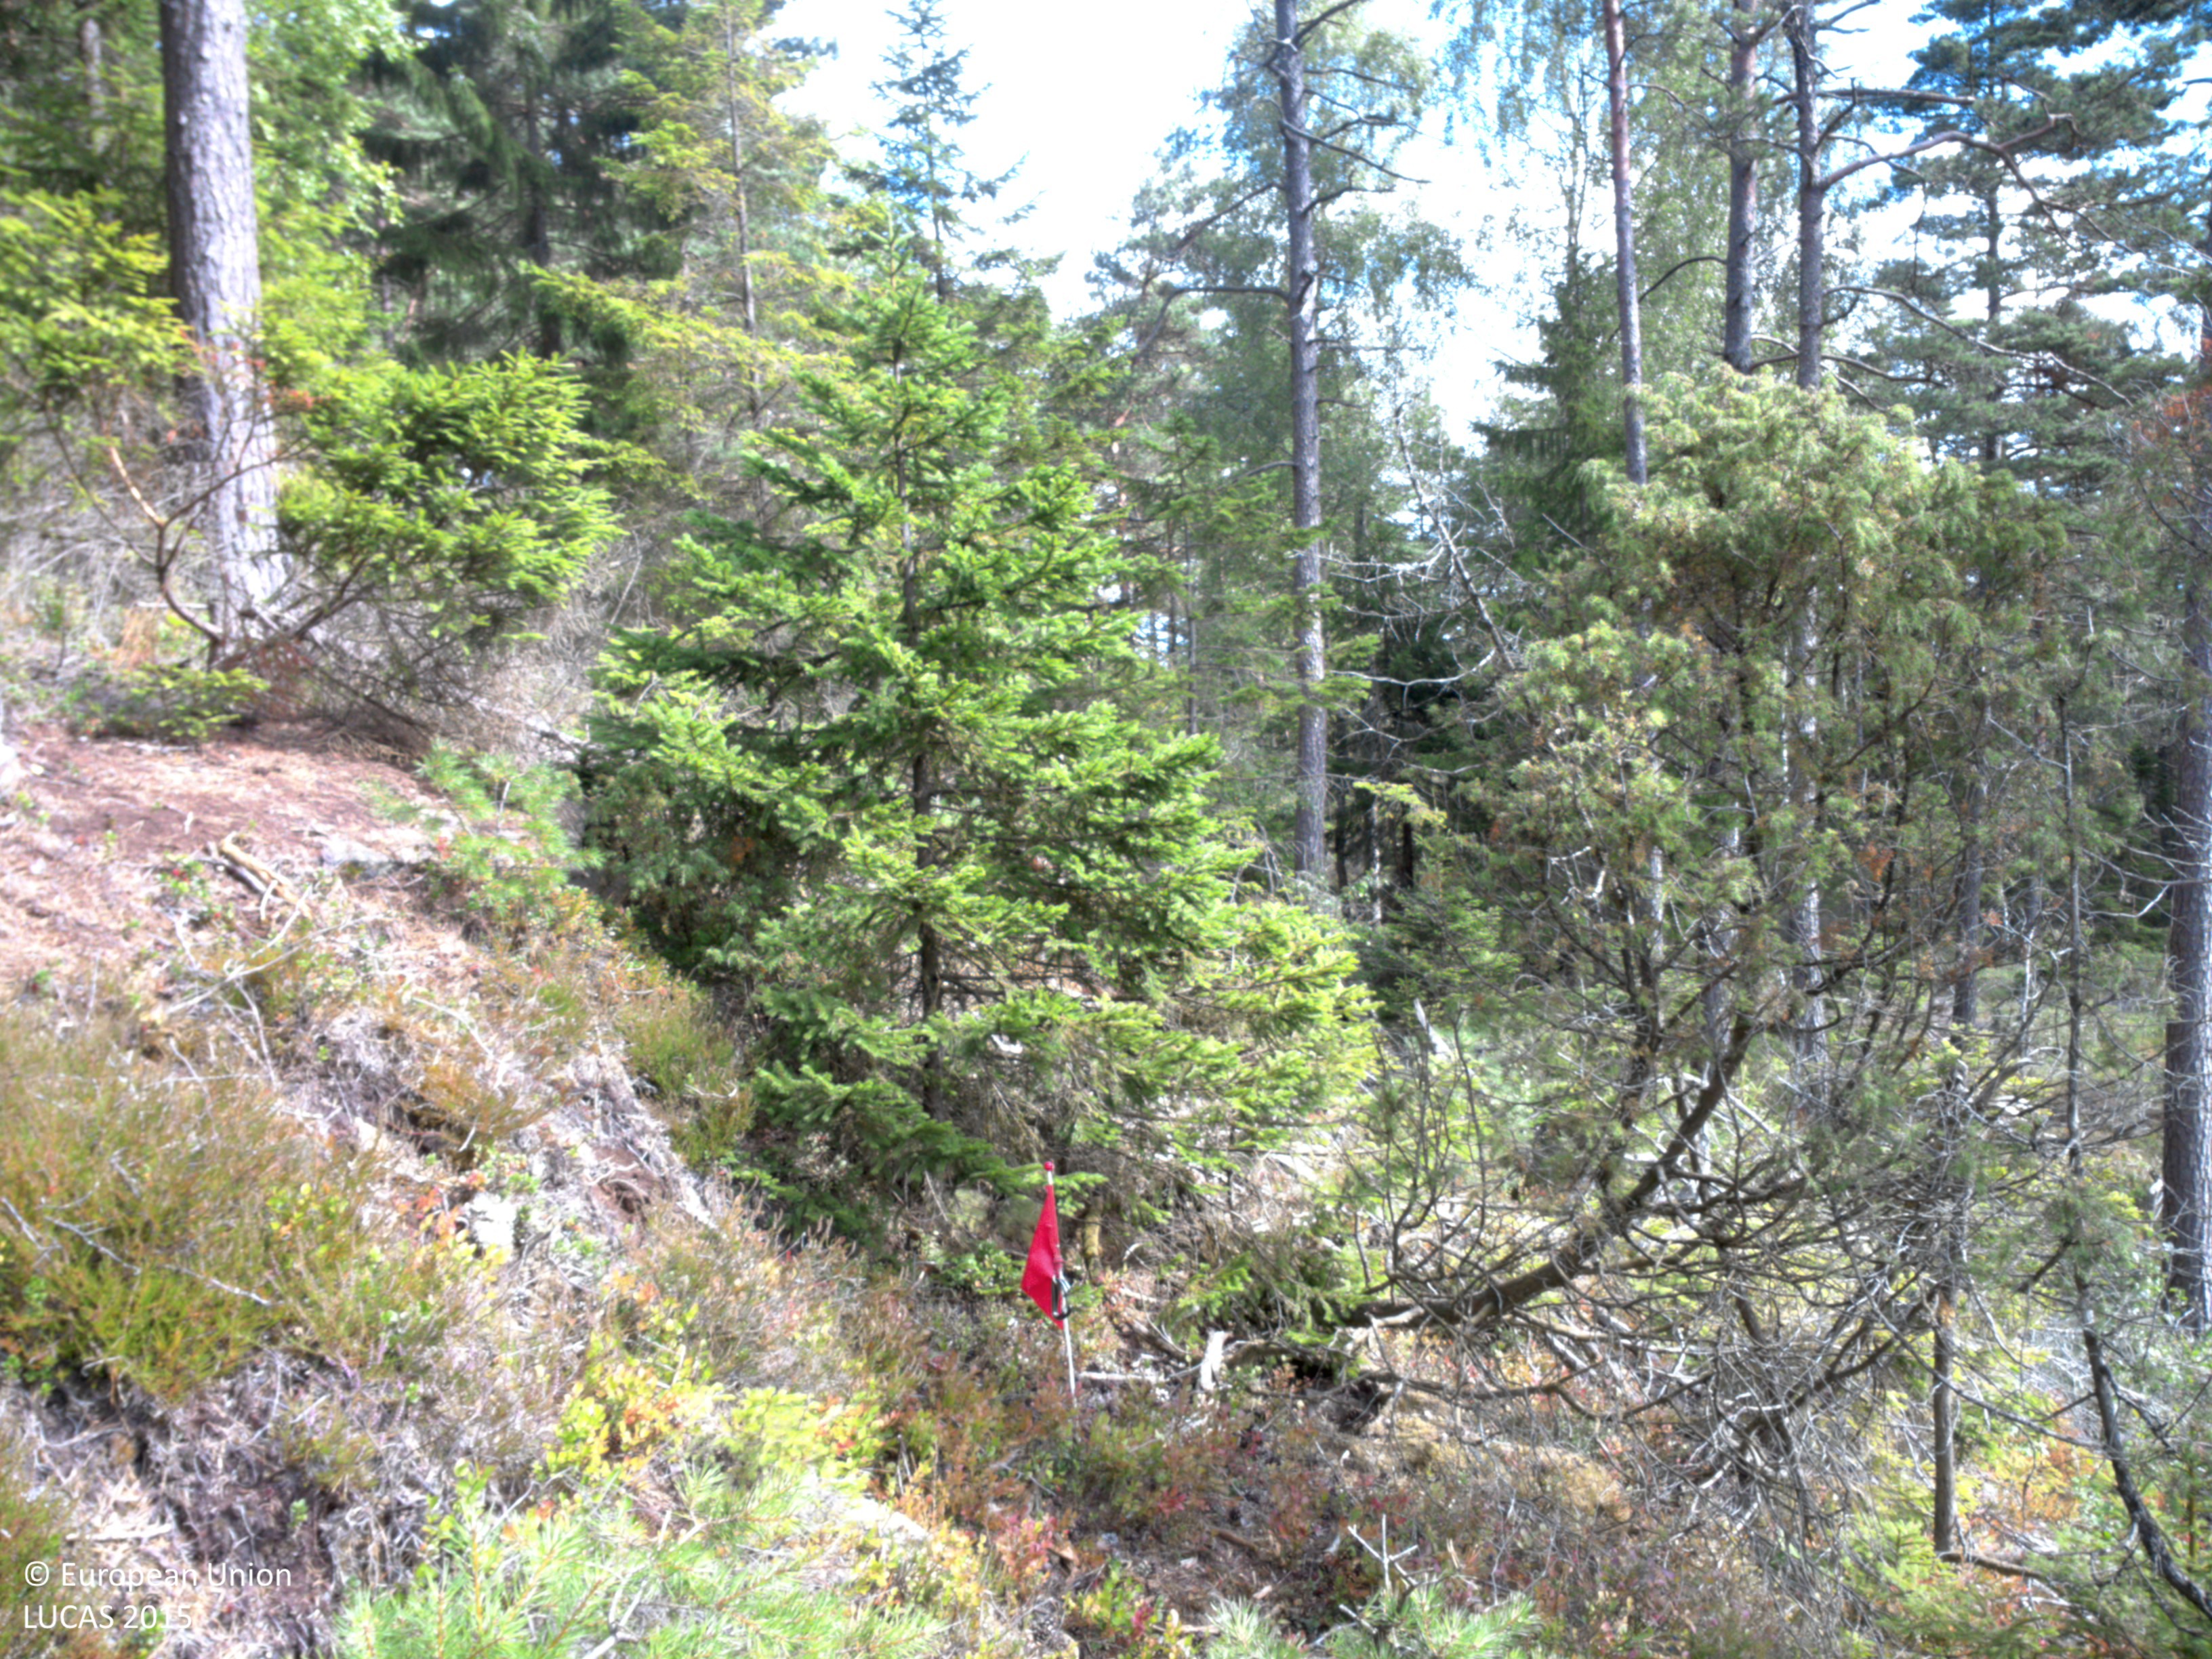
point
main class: Woodland
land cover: Other coniferous woodland
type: boreal forest
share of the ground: 25 - 50 %
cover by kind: coniferous forest trees 40 %, shrubs 35 %, lichens and mosses 10 %, unconsolidated bare surface 10 %, broadleaved forest trees 5 %
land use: Forestry
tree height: > 5 m
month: July
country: SE
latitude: 58.2436
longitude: 11.7852
